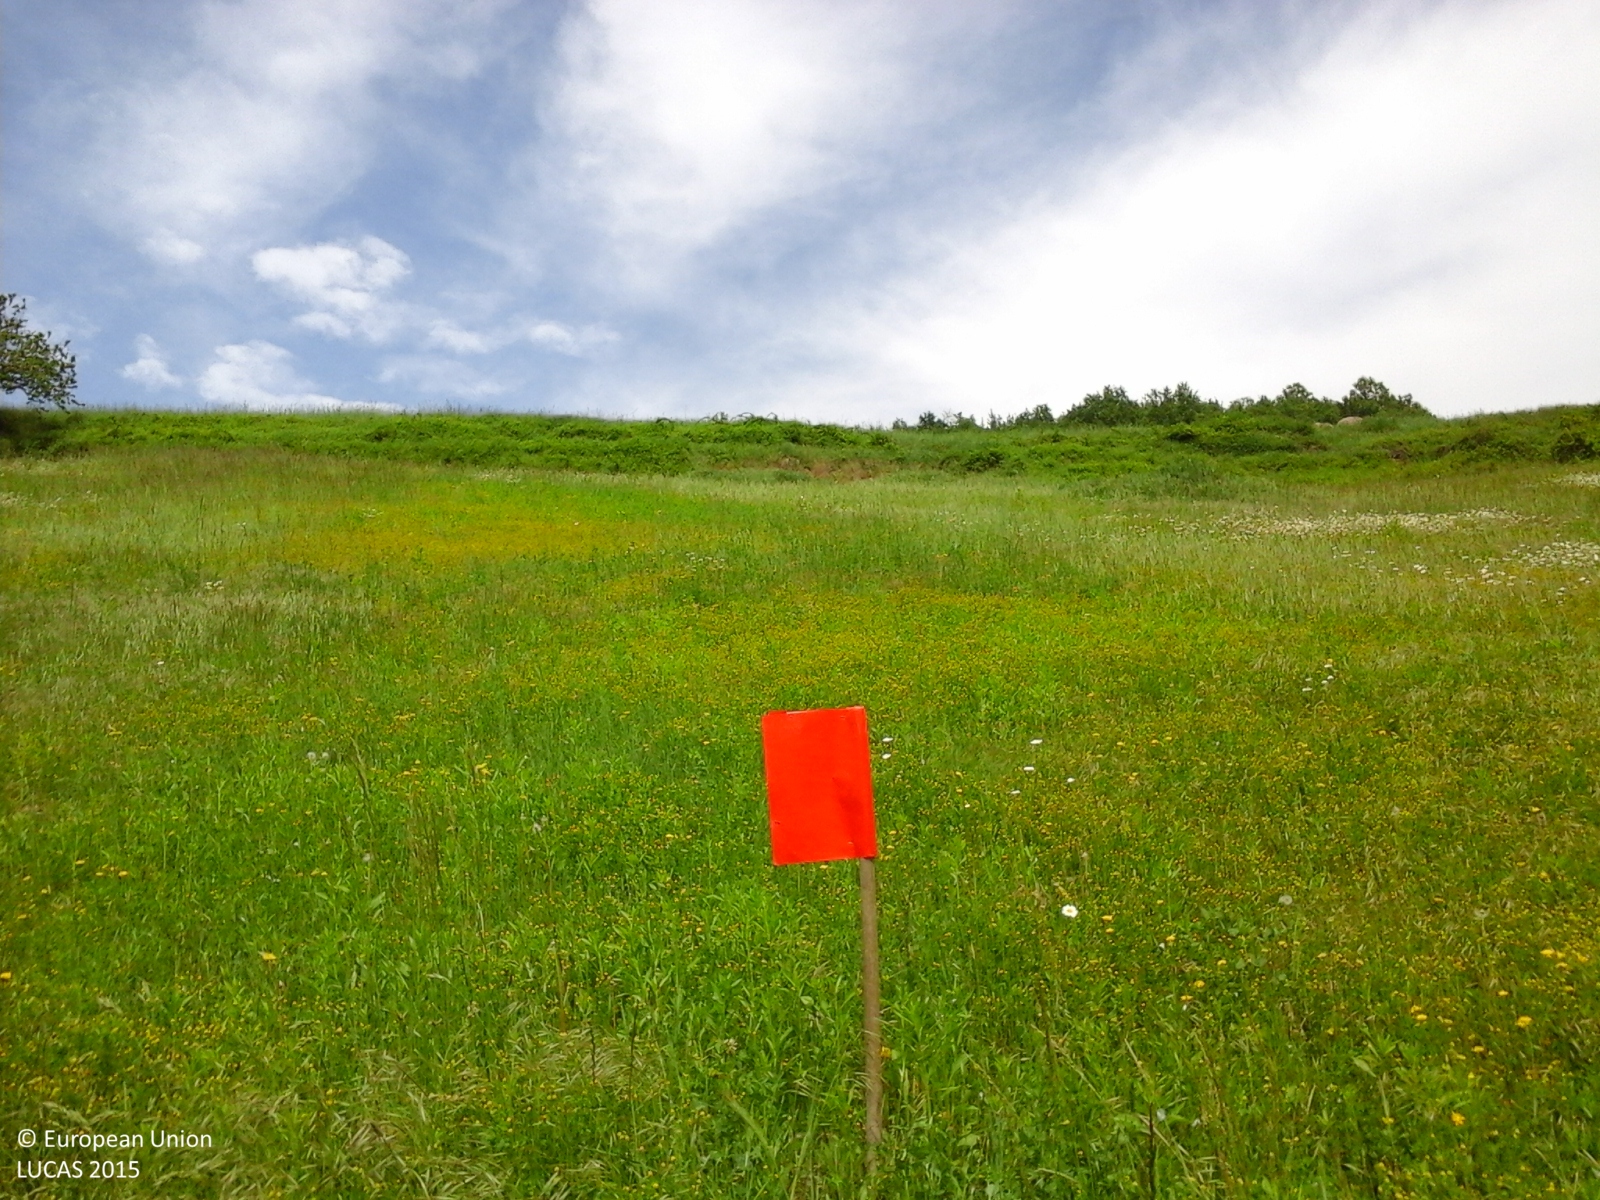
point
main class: Grassland
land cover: Grassland without tree/shrub cover
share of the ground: > 75 %
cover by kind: herbaceous plants 100 %
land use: Agriculture (excluding fallow land and kitchen gardens)
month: May
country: IT
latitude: 44.8185
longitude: 9.5583
